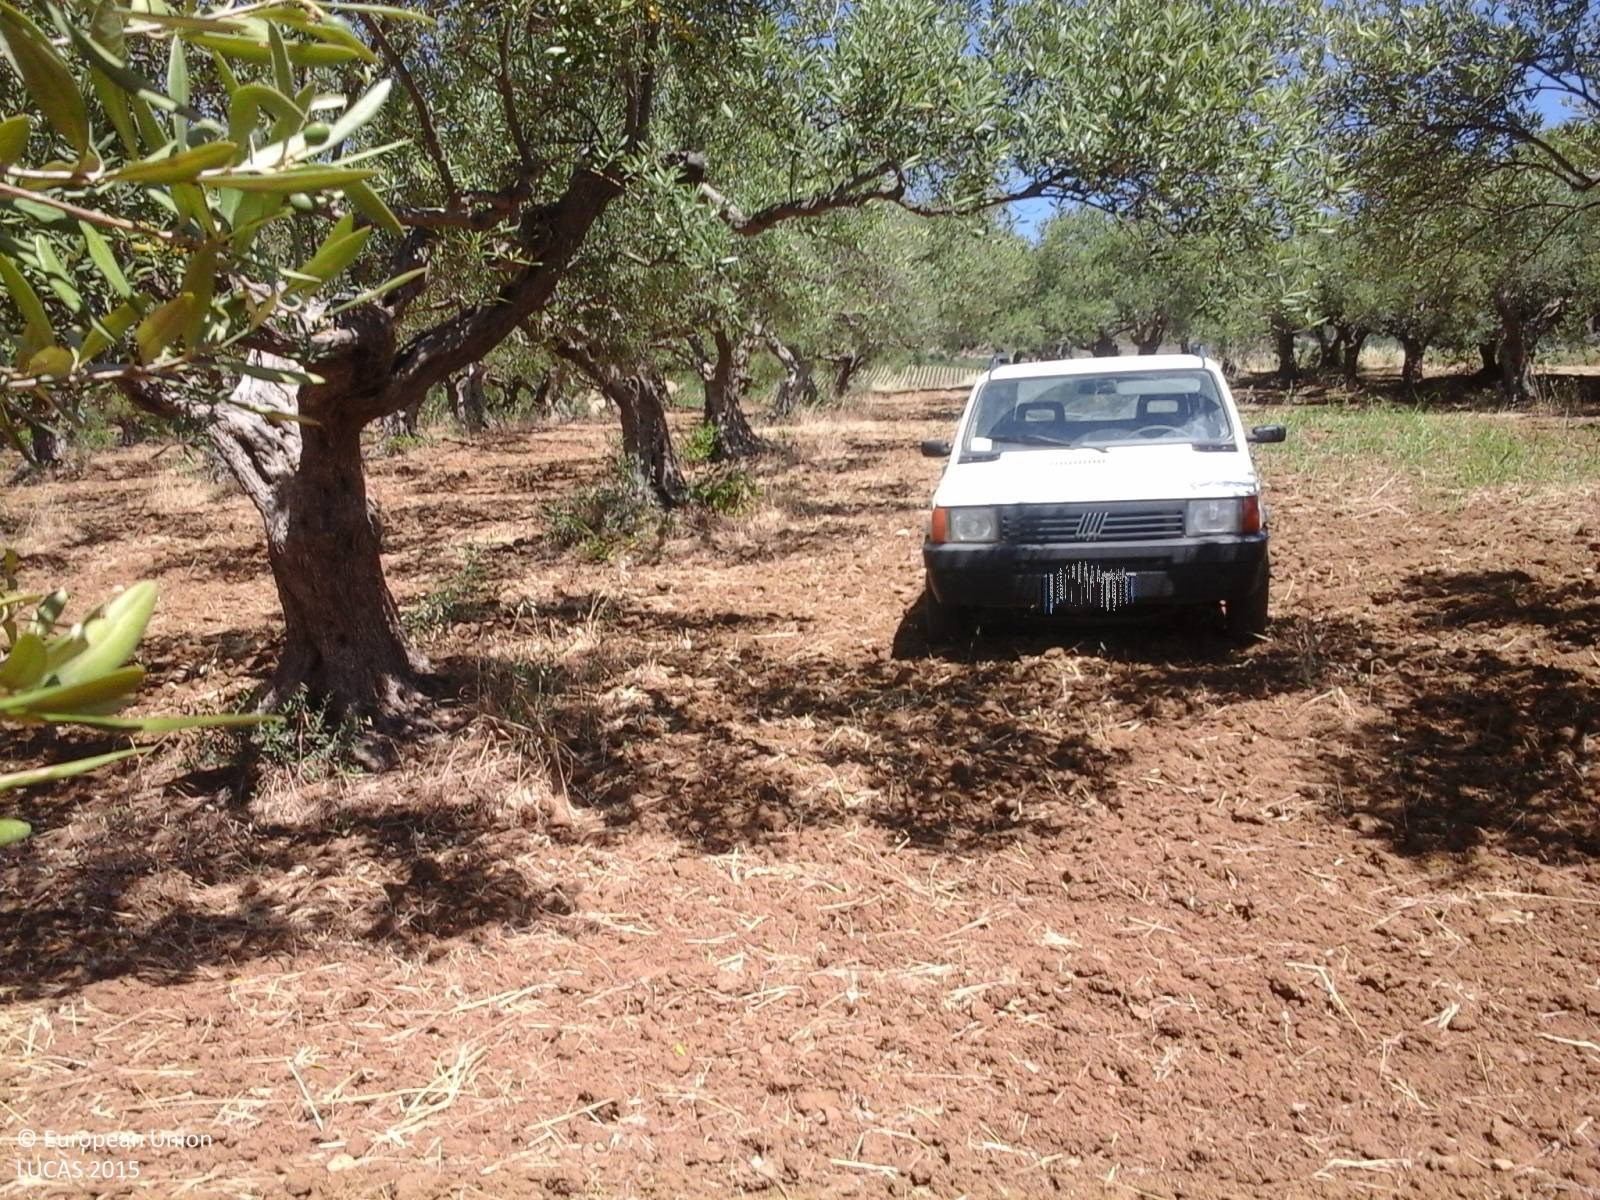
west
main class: Cropland
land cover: Olive groves
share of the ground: 50 - 75 %
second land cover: Other bare soil
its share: > 75 %
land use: Agriculture (excluding fallow land and kitchen gardens)
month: June
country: IT
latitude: 37.8500
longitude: 12.8543
